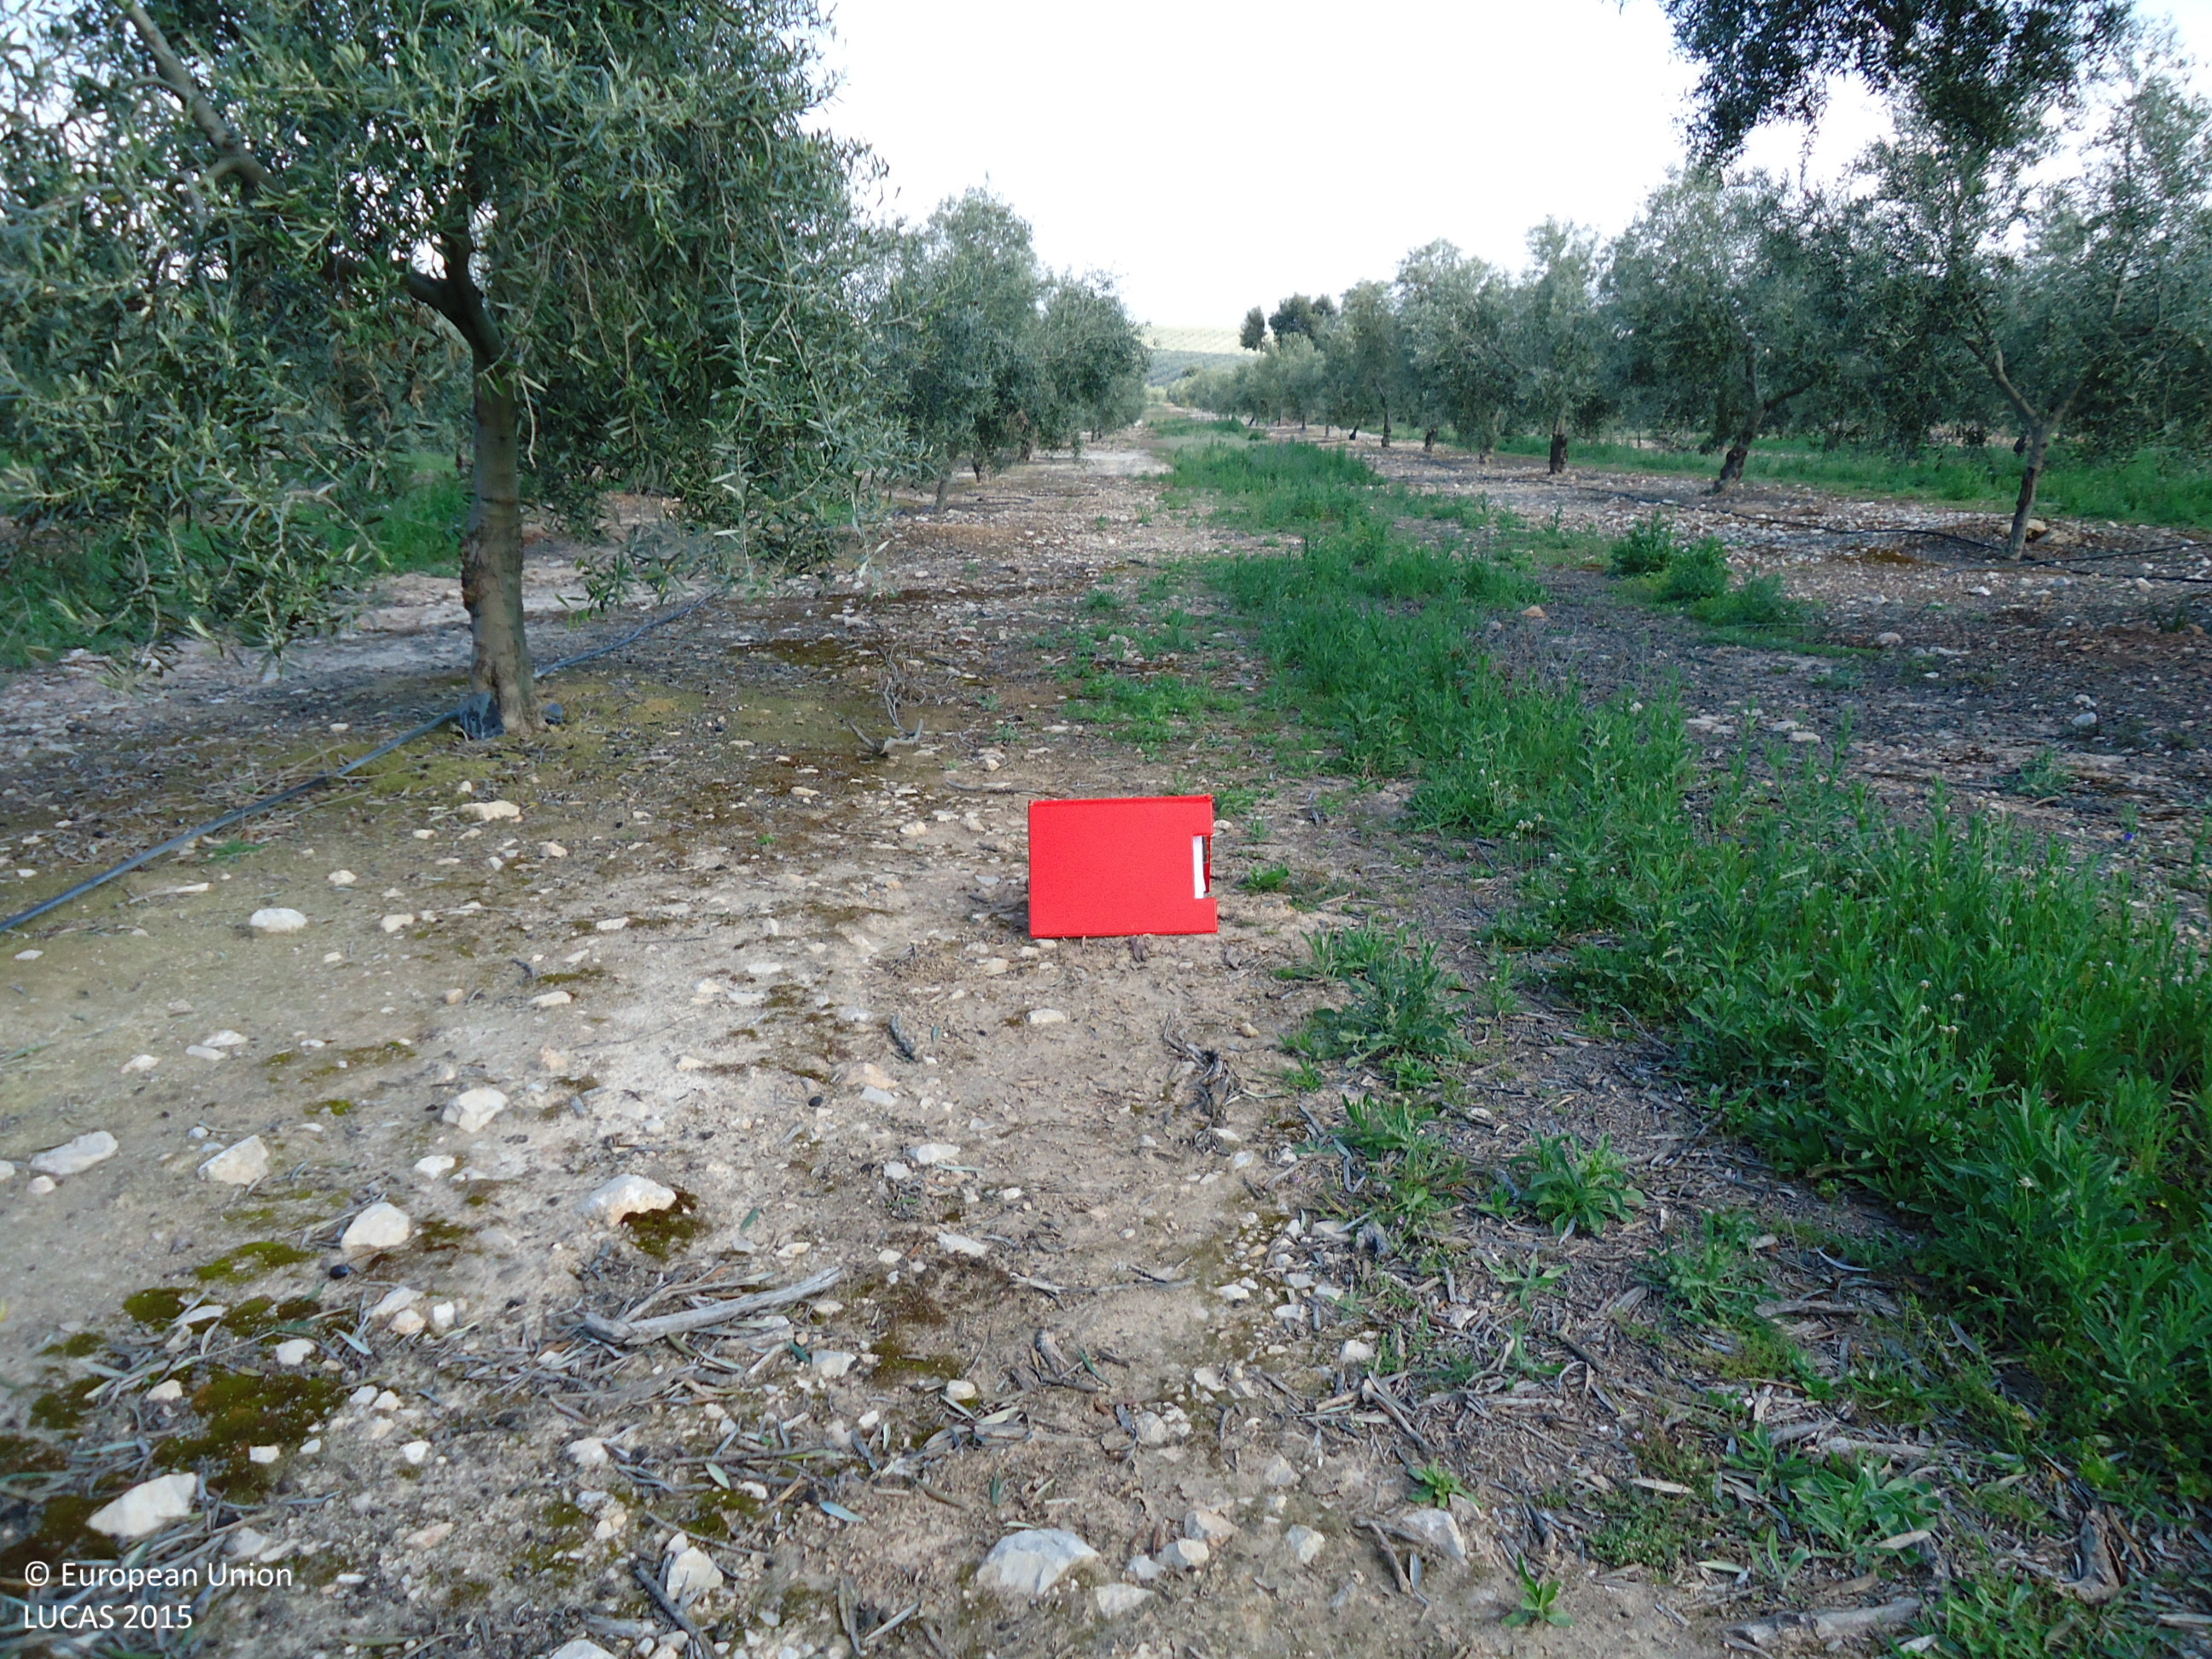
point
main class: Cropland
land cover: Olive groves
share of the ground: 25 - 50 %
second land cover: Spontaneously vegetated surfaces
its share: 50 - 75 %
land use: Agriculture (excluding fallow land and kitchen gardens)
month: April
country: ES
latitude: 37.1802
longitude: -4.8600
